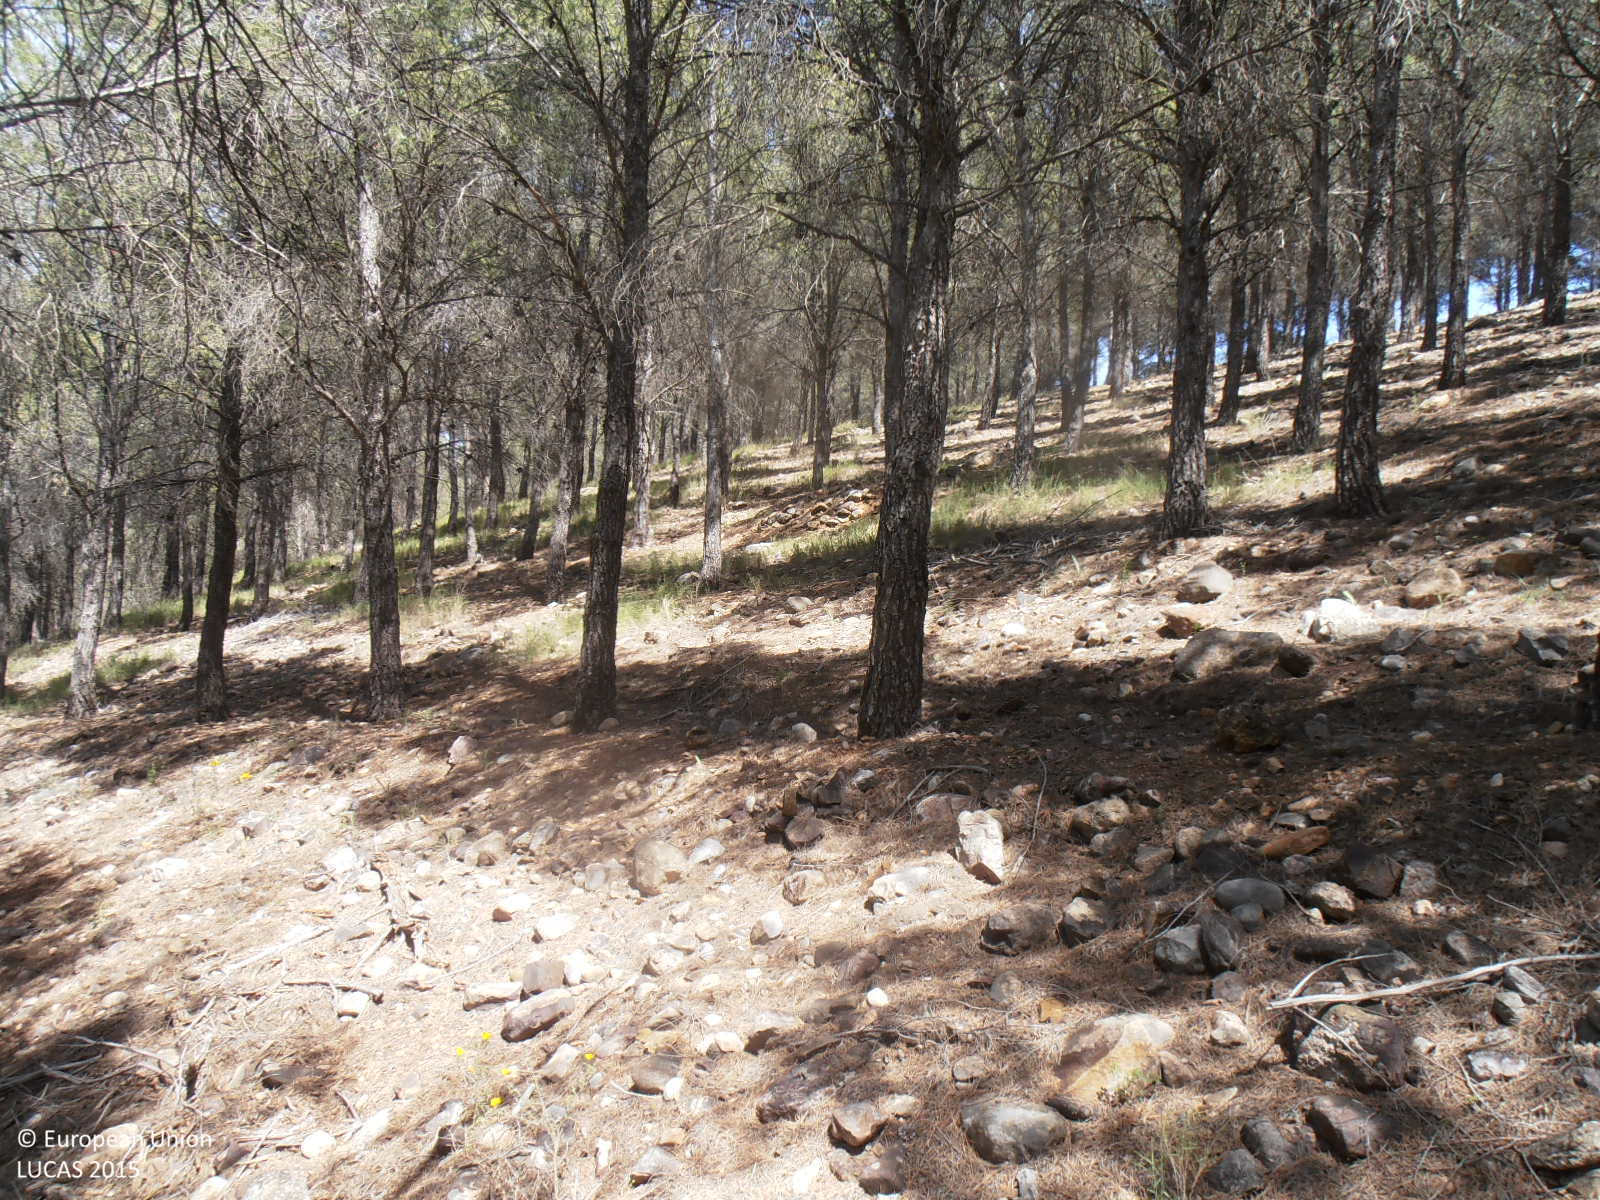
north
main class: Woodland
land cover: Pine dominated coniferous woodland
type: coniferous forest of the mediterranean region
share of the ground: > 75 %
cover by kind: coniferous forest trees 80 %, herbaceous plants 20 %
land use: Forestry
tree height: > 5 m
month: April
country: ES
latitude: 41.2404
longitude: -0.9361
